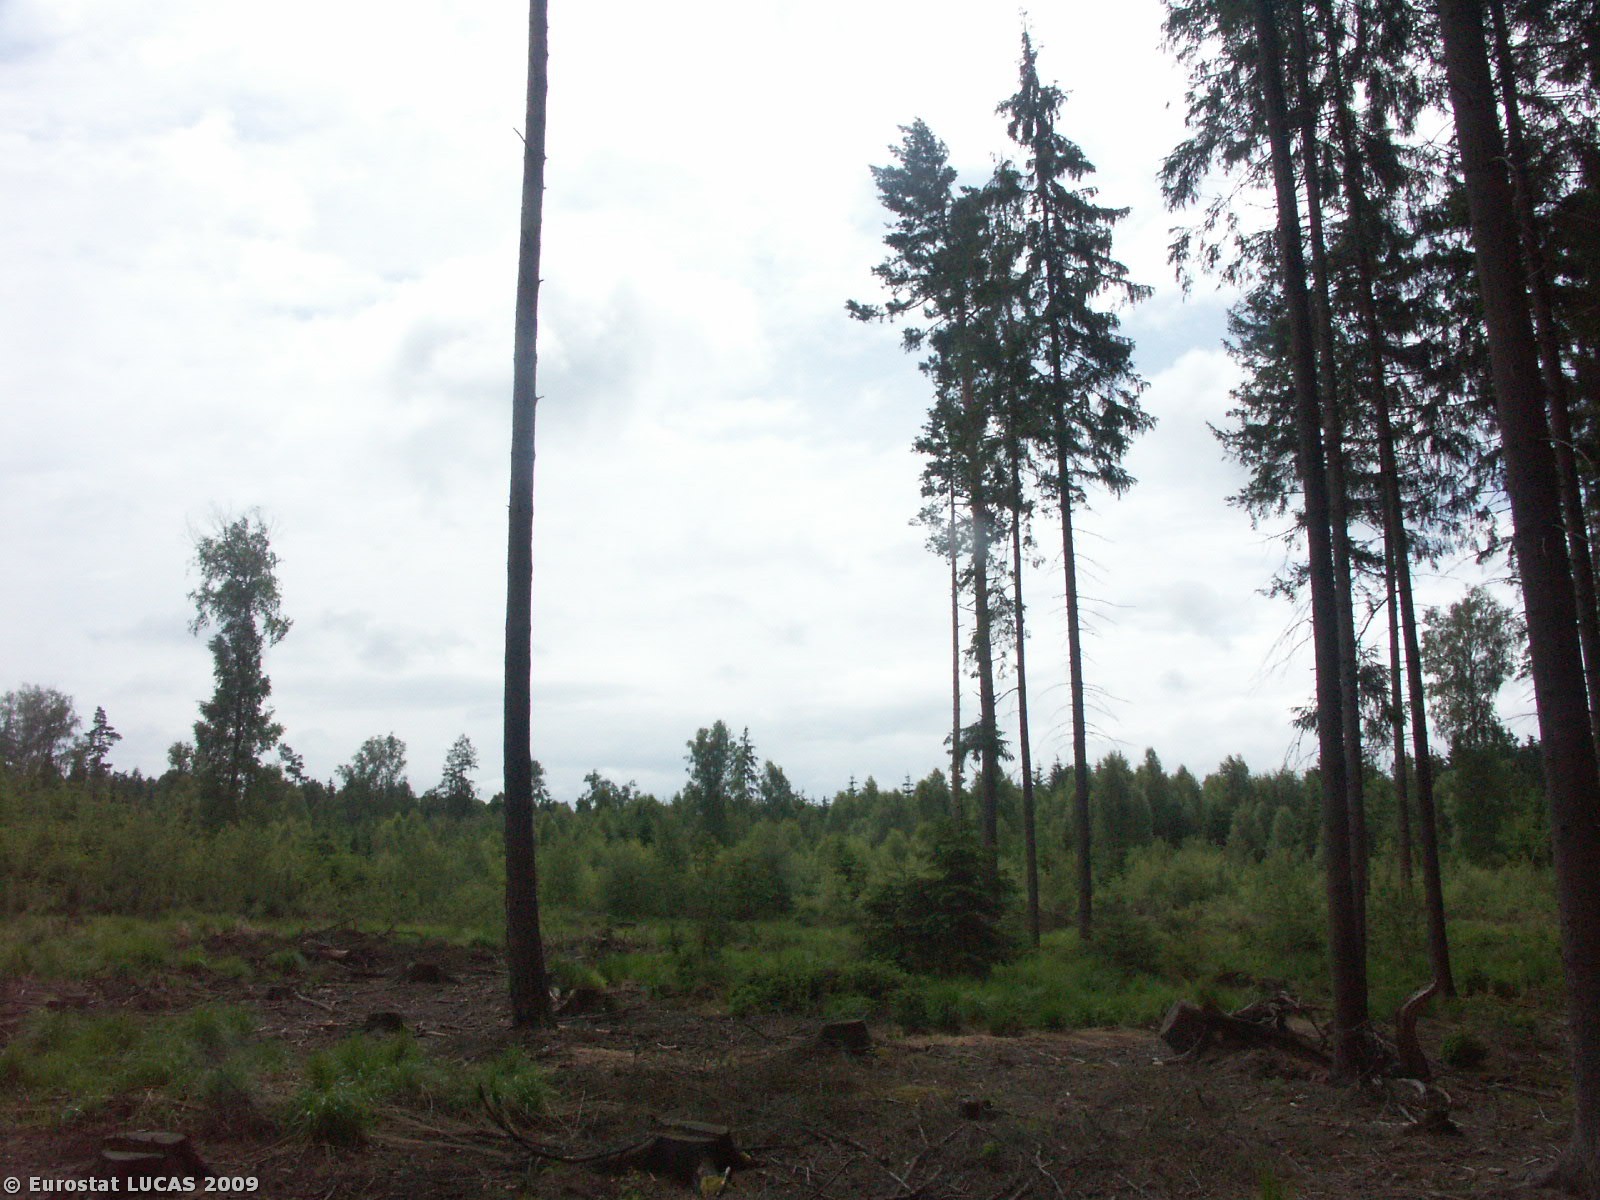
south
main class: Woodland
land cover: Coniferous woodland
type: hemiboreal forest and nemoral coniferous forest and mixed broadleaved-coniferous forest
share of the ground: > 75 %
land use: Forestry
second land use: Nature reserves
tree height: > 5 m
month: May
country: CZ
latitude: 48.9843
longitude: 14.7979
